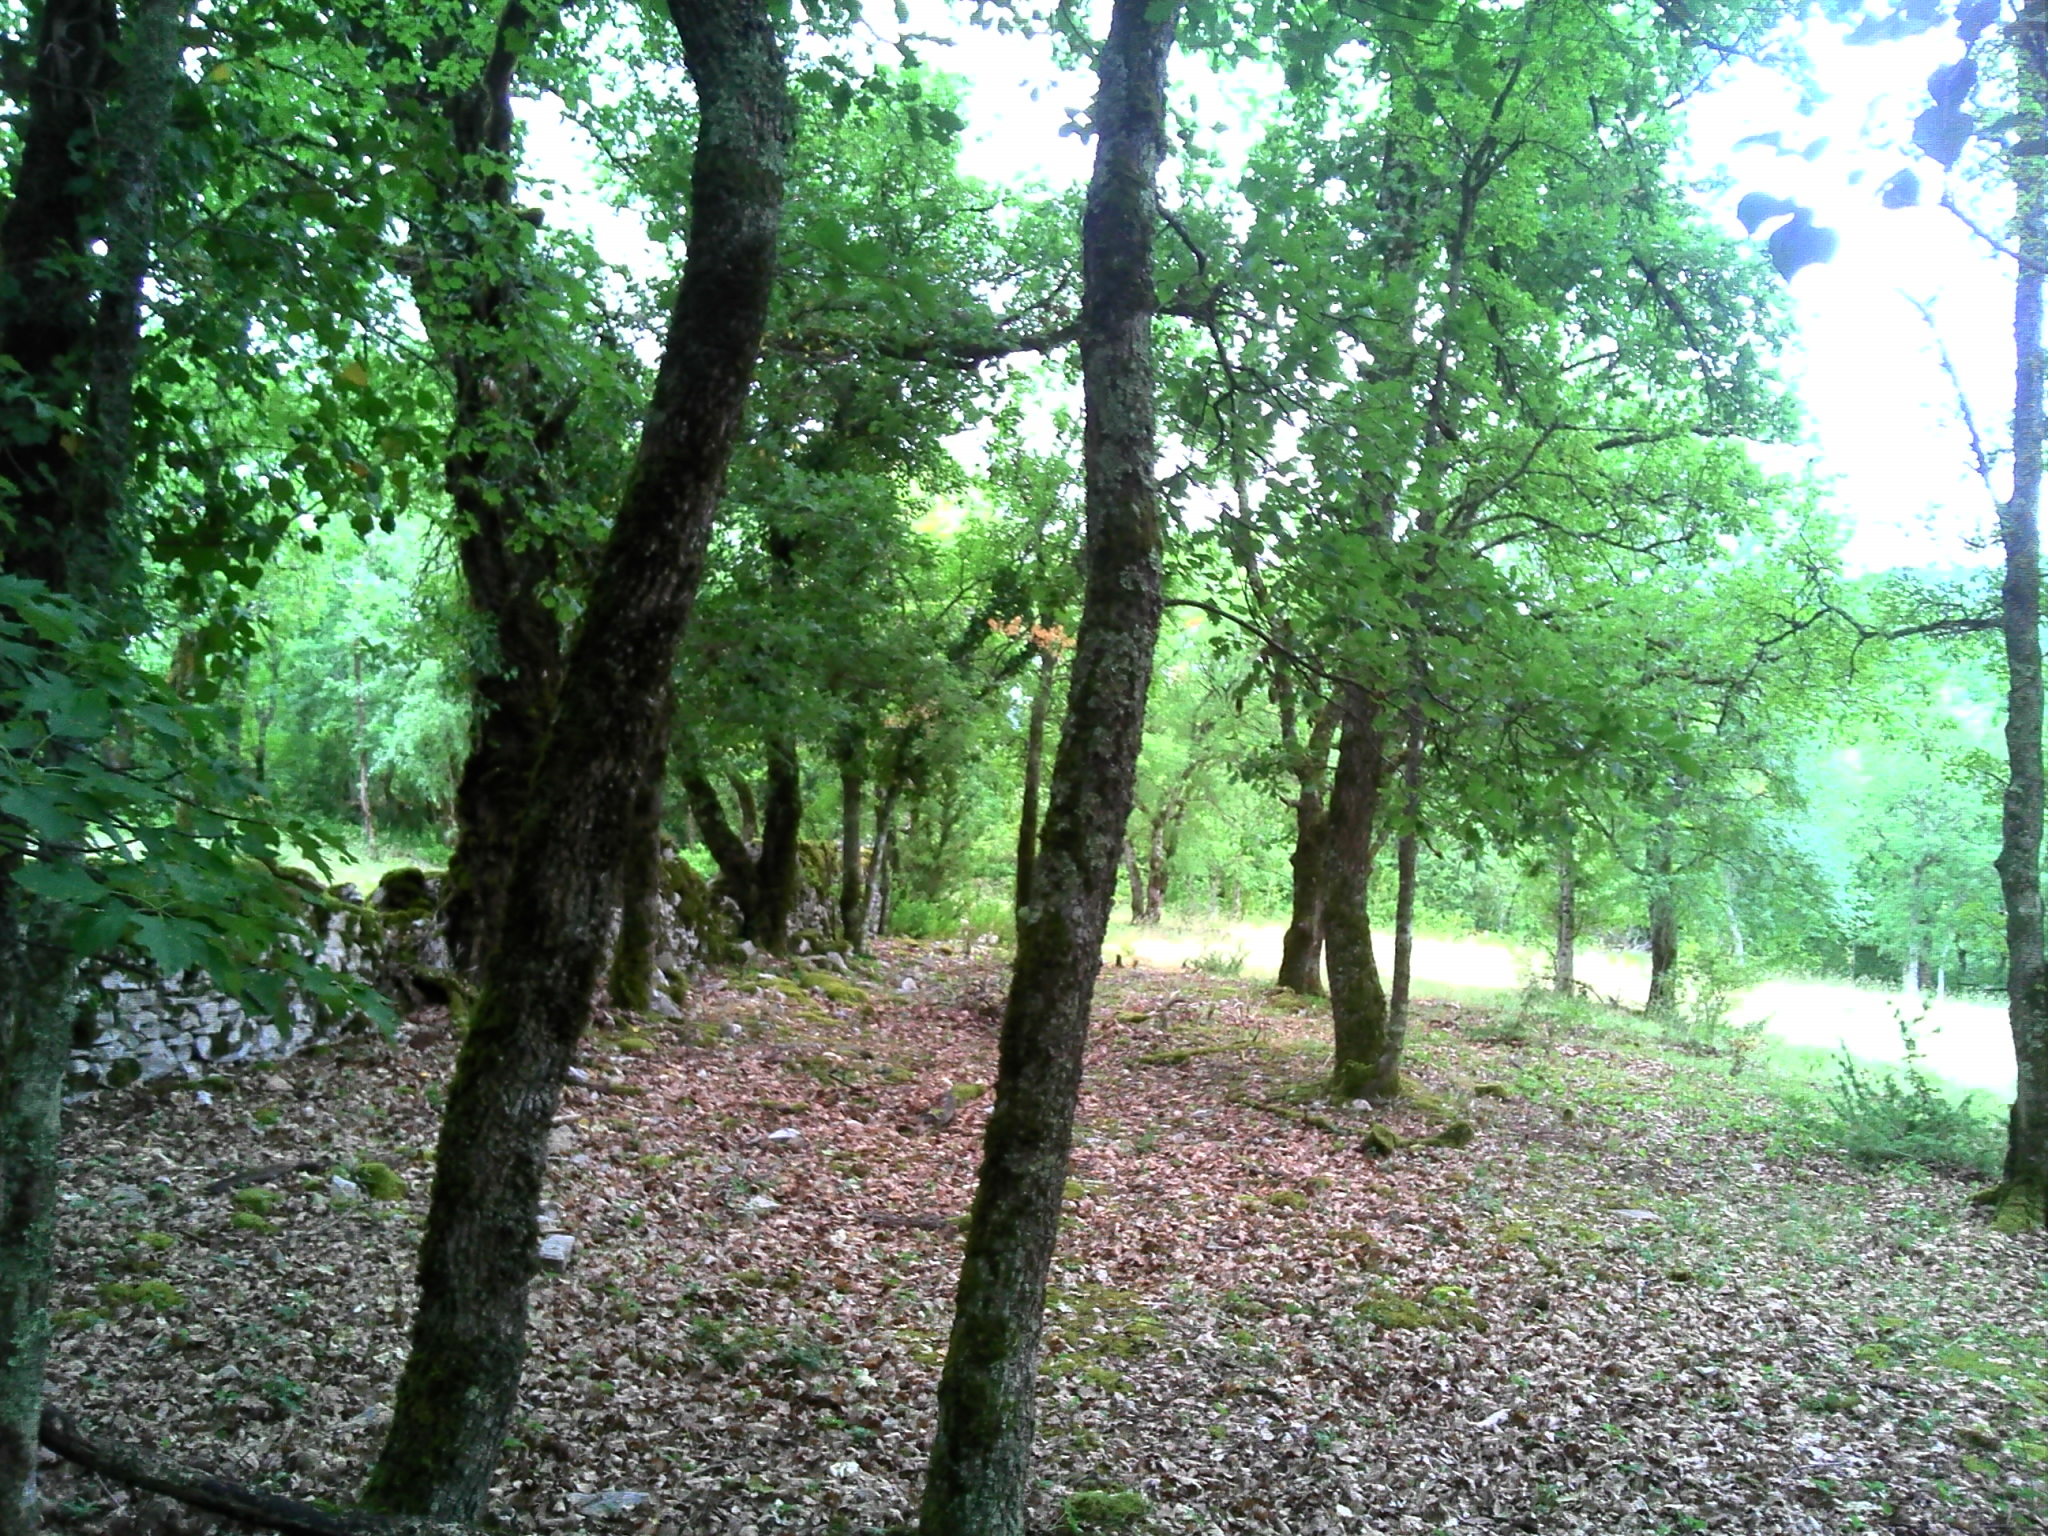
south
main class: Woodland
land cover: Broadleaved woodland
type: acidophilous oak and oak-birch forest
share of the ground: > 75 %
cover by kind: broadleaved forest trees 90 %, herbaceous plants 10 %
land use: Forestry
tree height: > 5 m
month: June
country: FR
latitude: 44.4440
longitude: 1.8202
